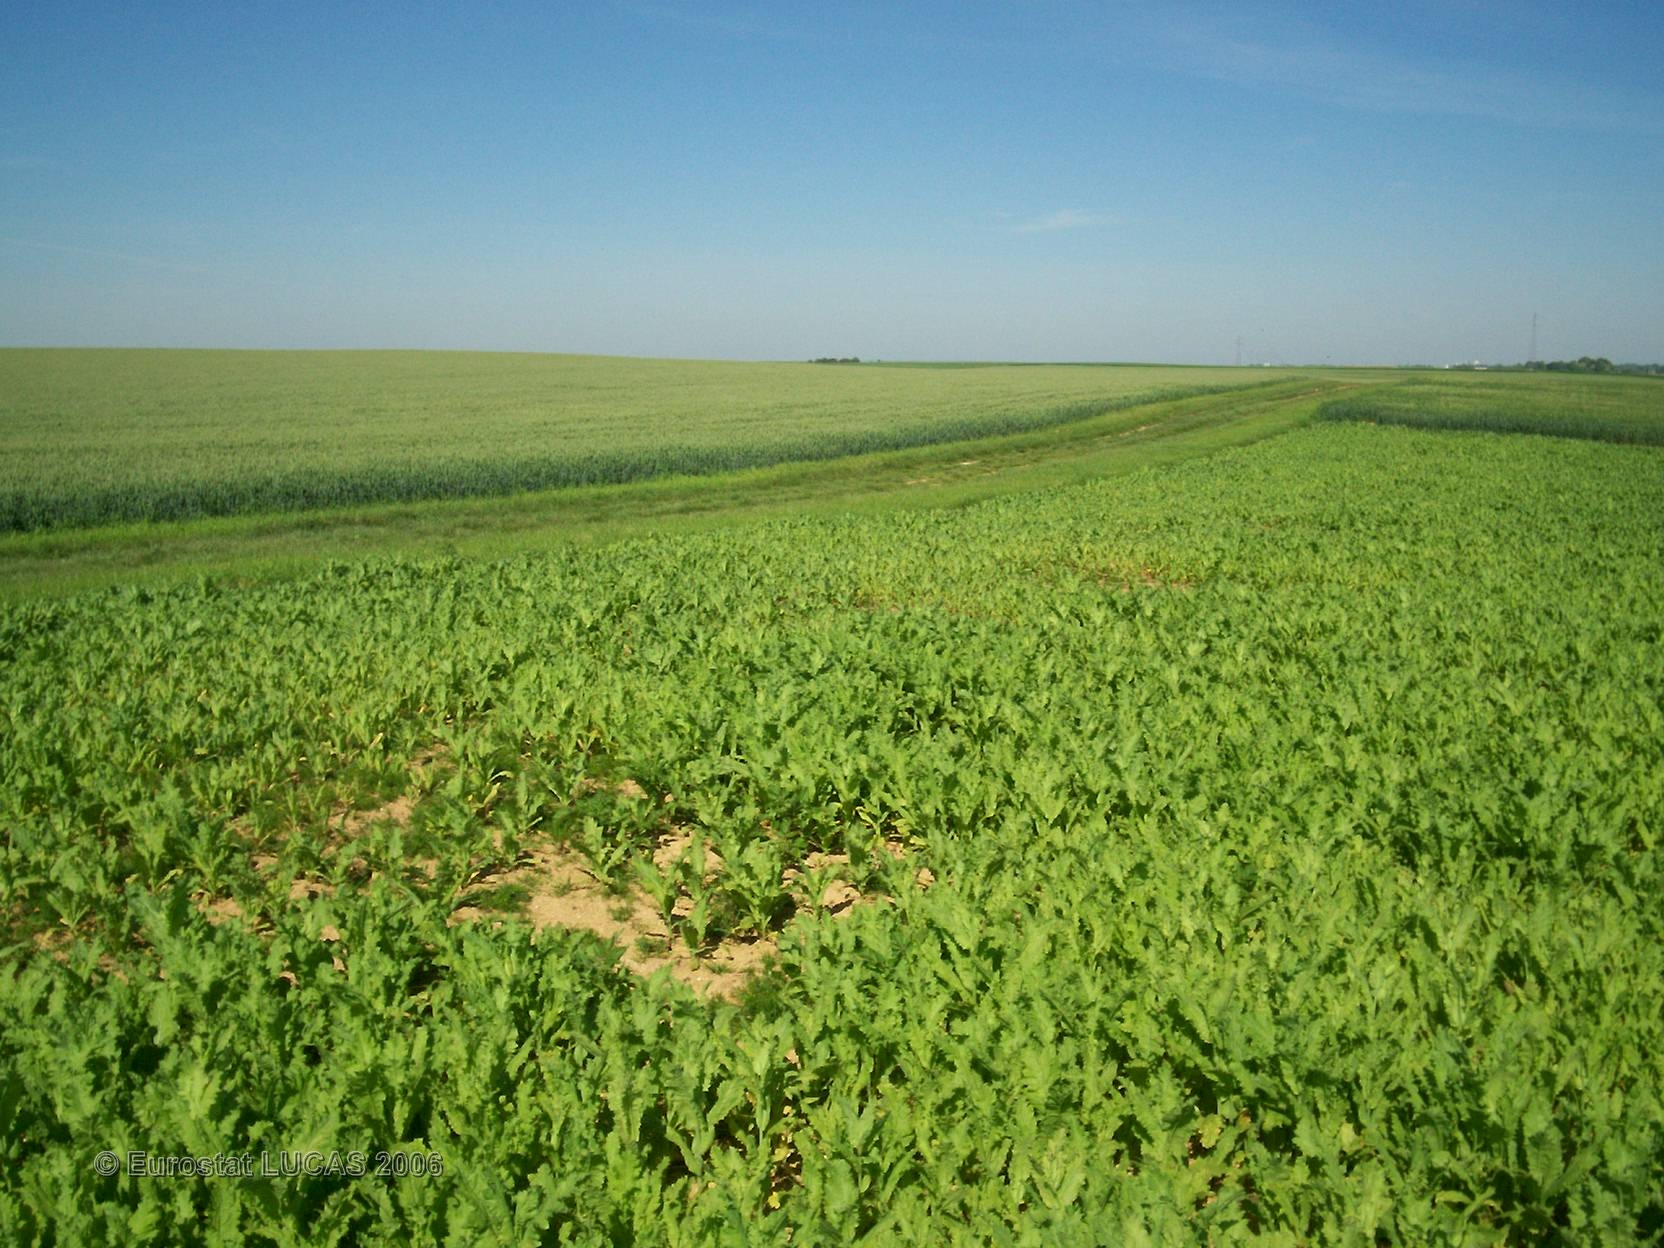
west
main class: Cropland
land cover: Other fibre and oleaginous crops
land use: Agriculture (excluding fallow land and kitchen gardens)
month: June
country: FR
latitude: 49.1017
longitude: 4.6140
